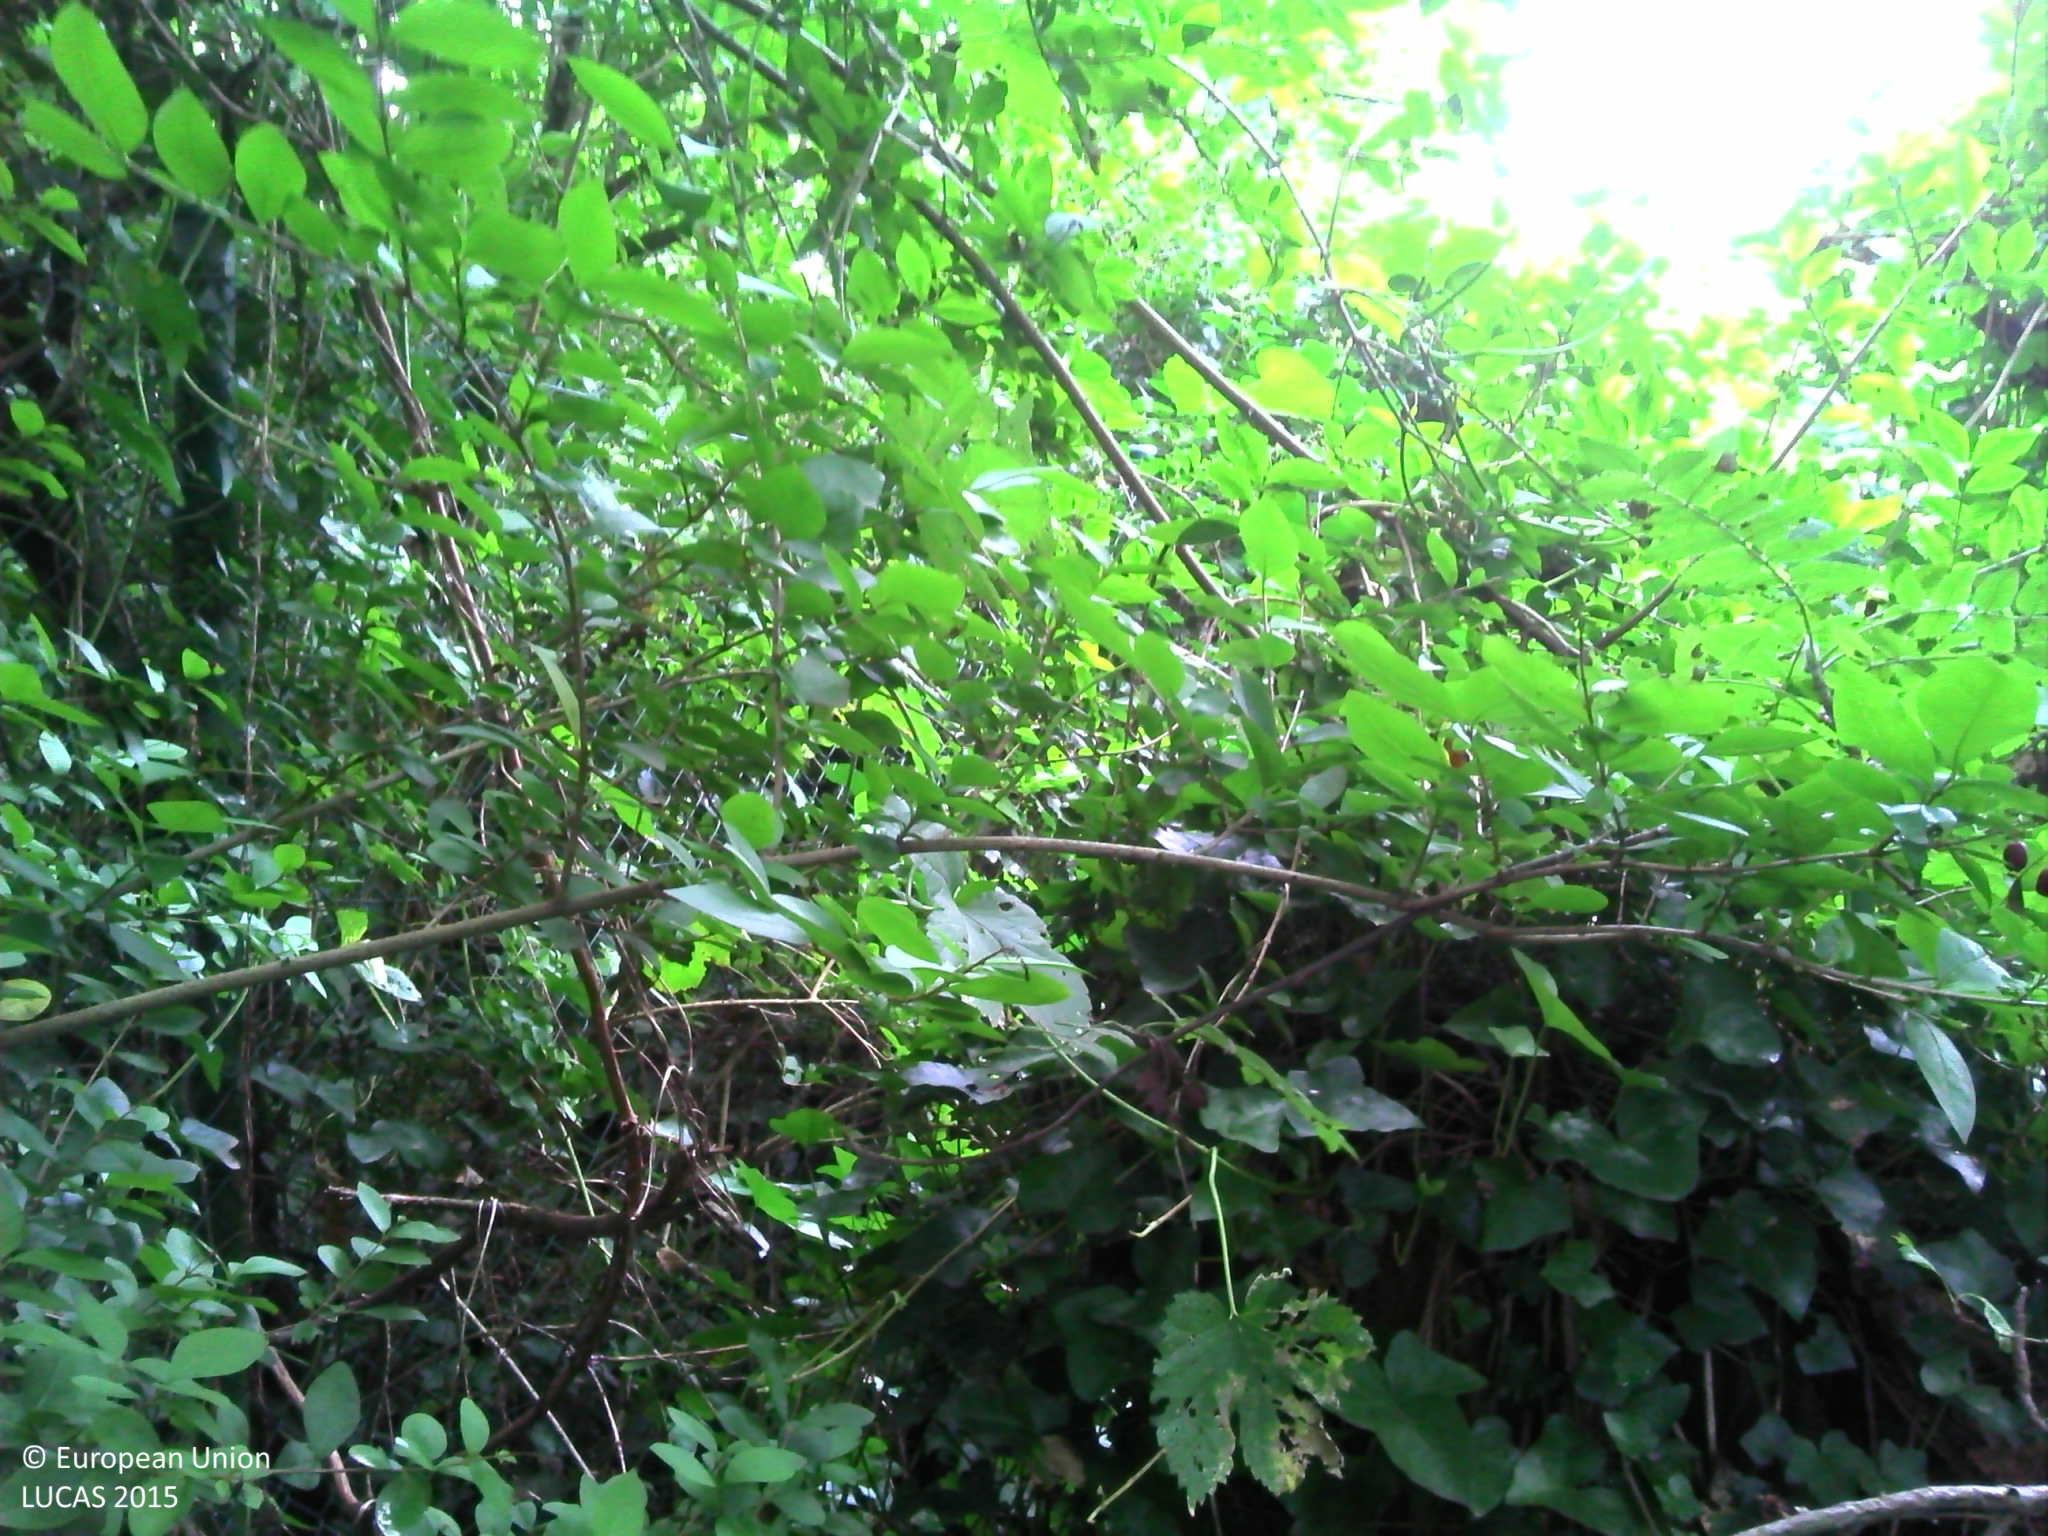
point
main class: Woodland
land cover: Broadleaved woodland
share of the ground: > 75 %
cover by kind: broadleaved forest trees 65 %, shrubs 15 %, coniferous forest trees 10 %, herbaceous plants 10 %
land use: Semi-natural and natural areas not in use
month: September
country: BE
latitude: 51.1616
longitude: 4.3470
